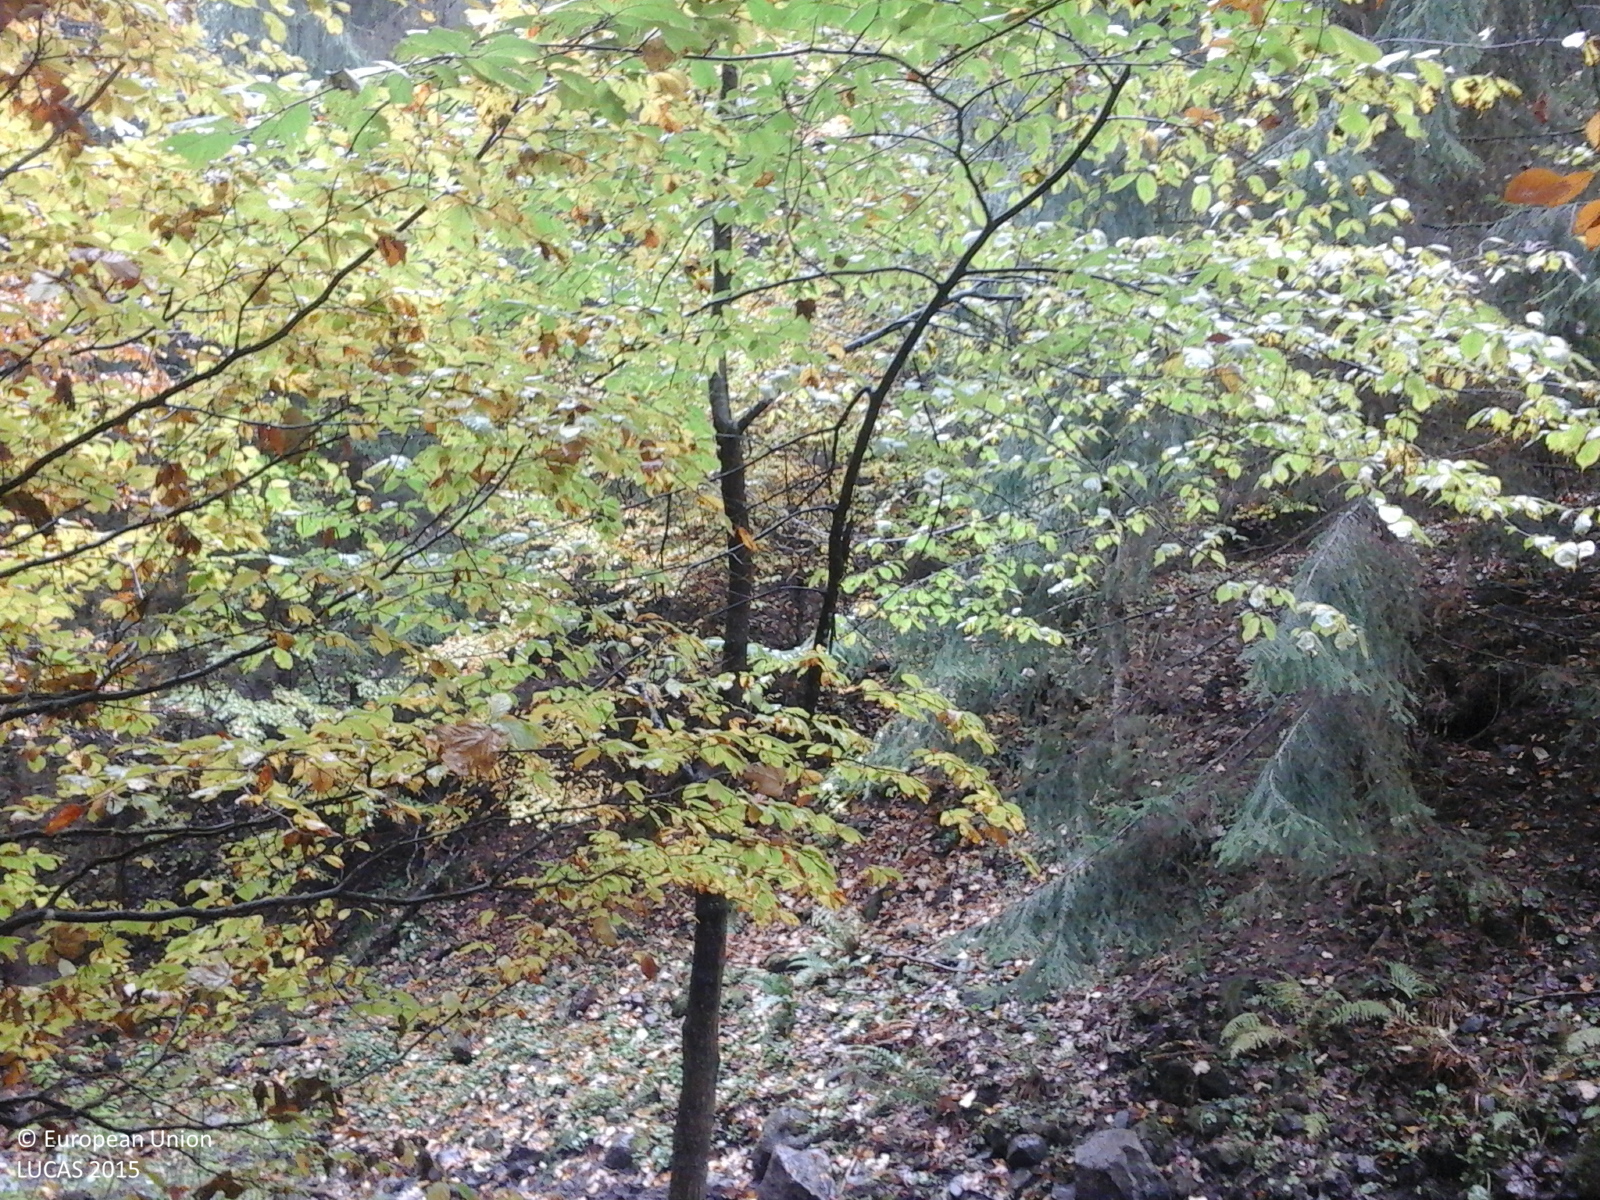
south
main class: Woodland
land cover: Broadleaved woodland
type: beech forest
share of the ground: > 75 %
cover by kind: broadleaved forest trees 100 %
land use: Forestry
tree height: > 5 m
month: October
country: RO
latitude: 46.7764
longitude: 25.2045
